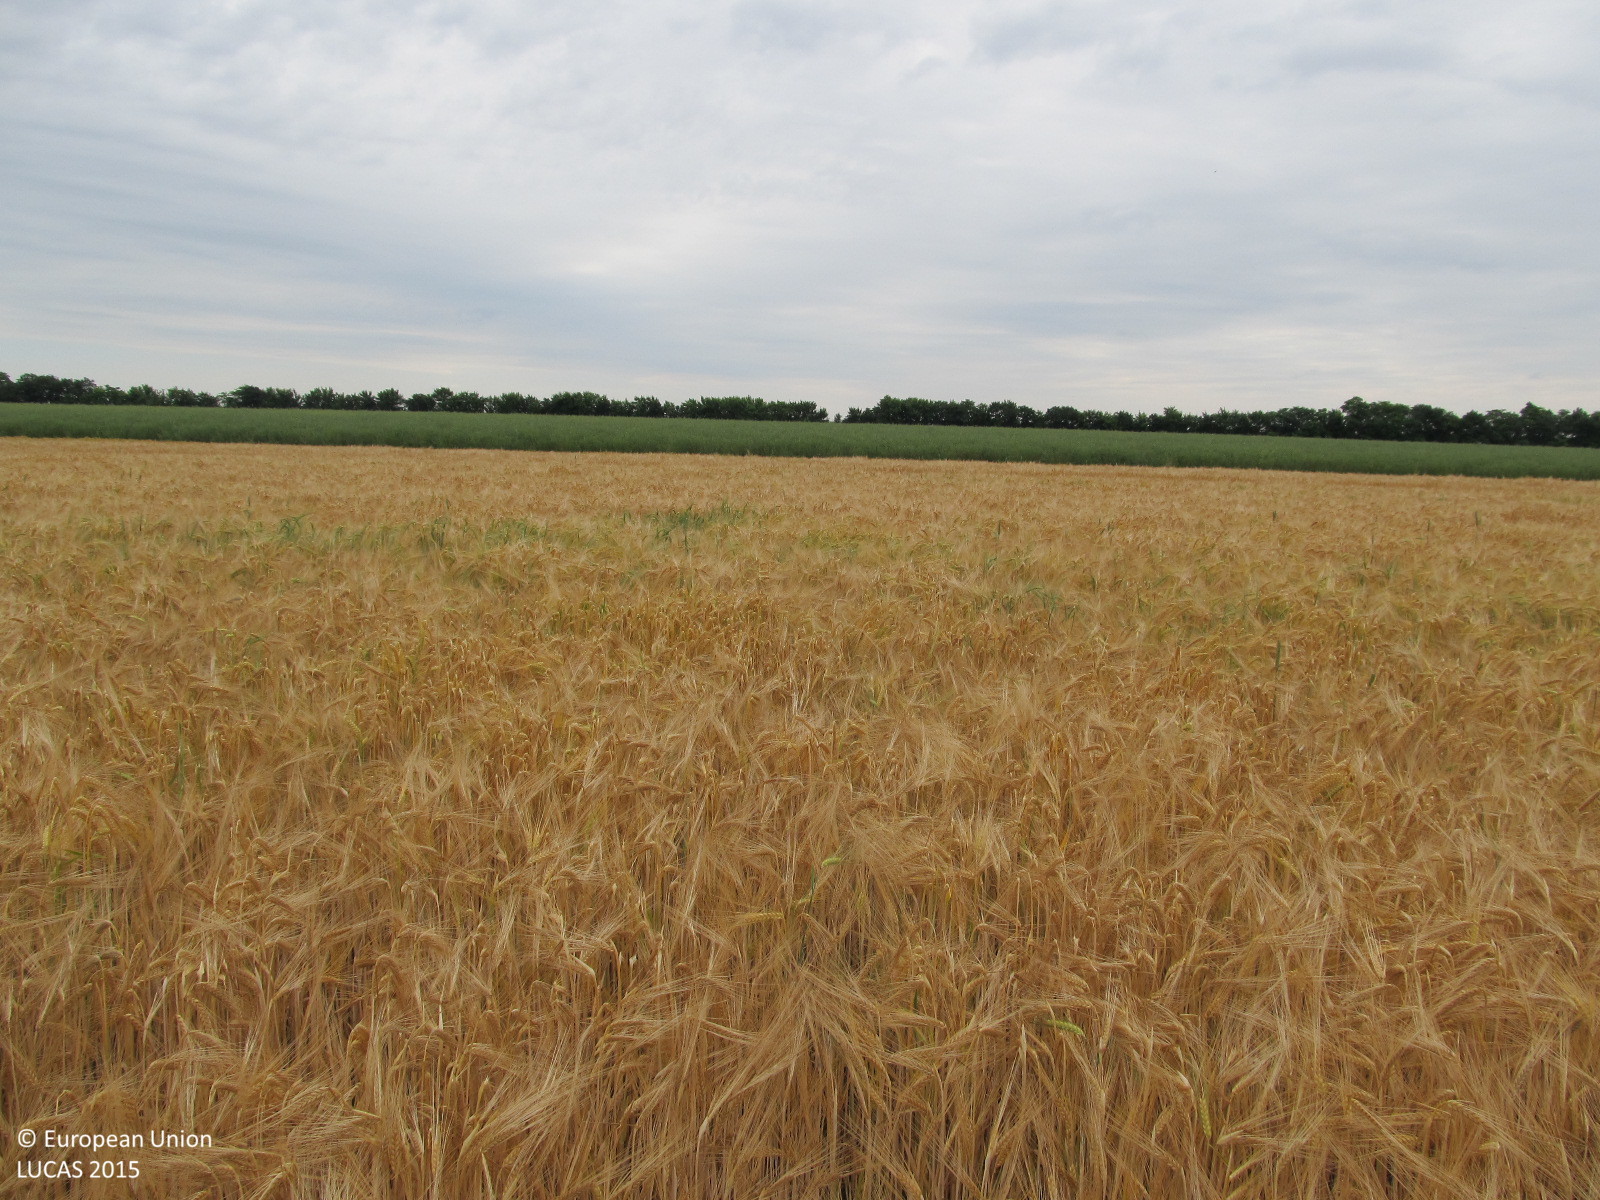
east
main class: Cropland
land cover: Barley
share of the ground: > 75 %
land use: Agriculture (excluding fallow land and kitchen gardens)
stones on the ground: < 10 %
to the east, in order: Barley; Rape and turnip rape; Barley; Maize
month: June
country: AT
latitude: 48.3419
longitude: 15.7913
